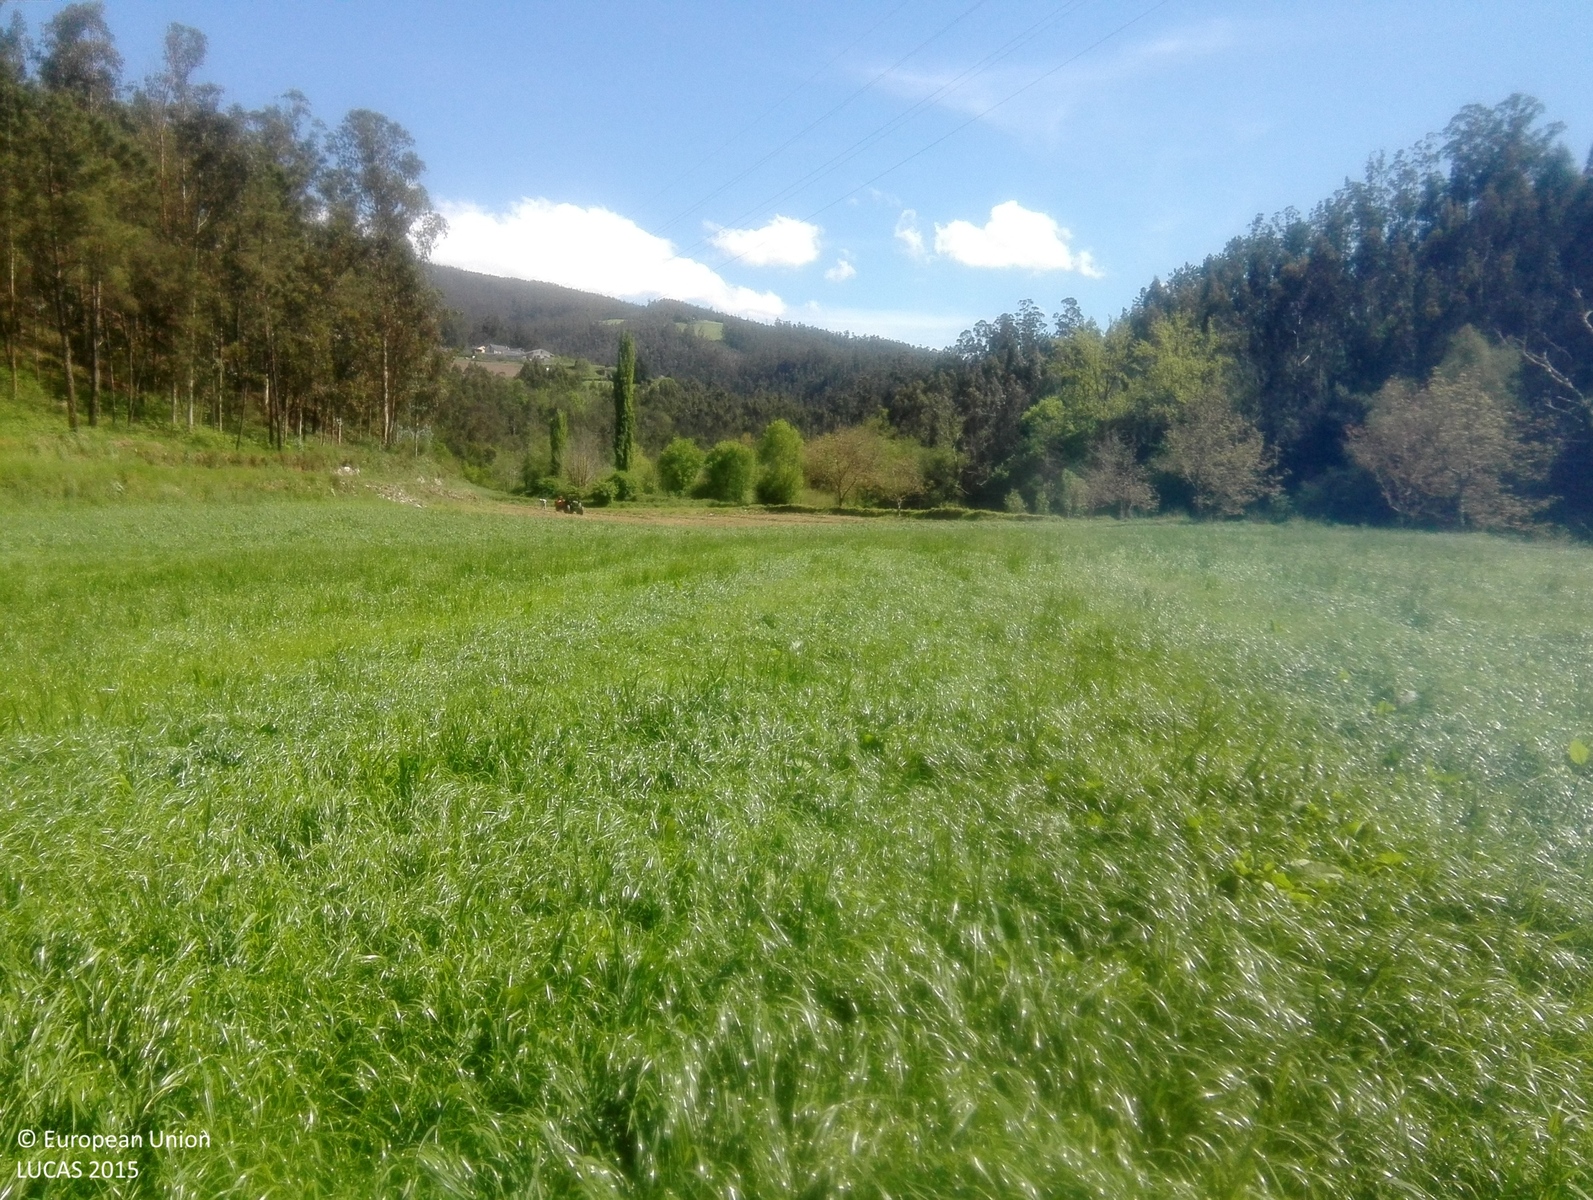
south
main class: Cropland
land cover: Temporary grasslands
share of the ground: > 75 %
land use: Agriculture (excluding fallow land and kitchen gardens)
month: April
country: ES
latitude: 43.4327
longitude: -7.1058
